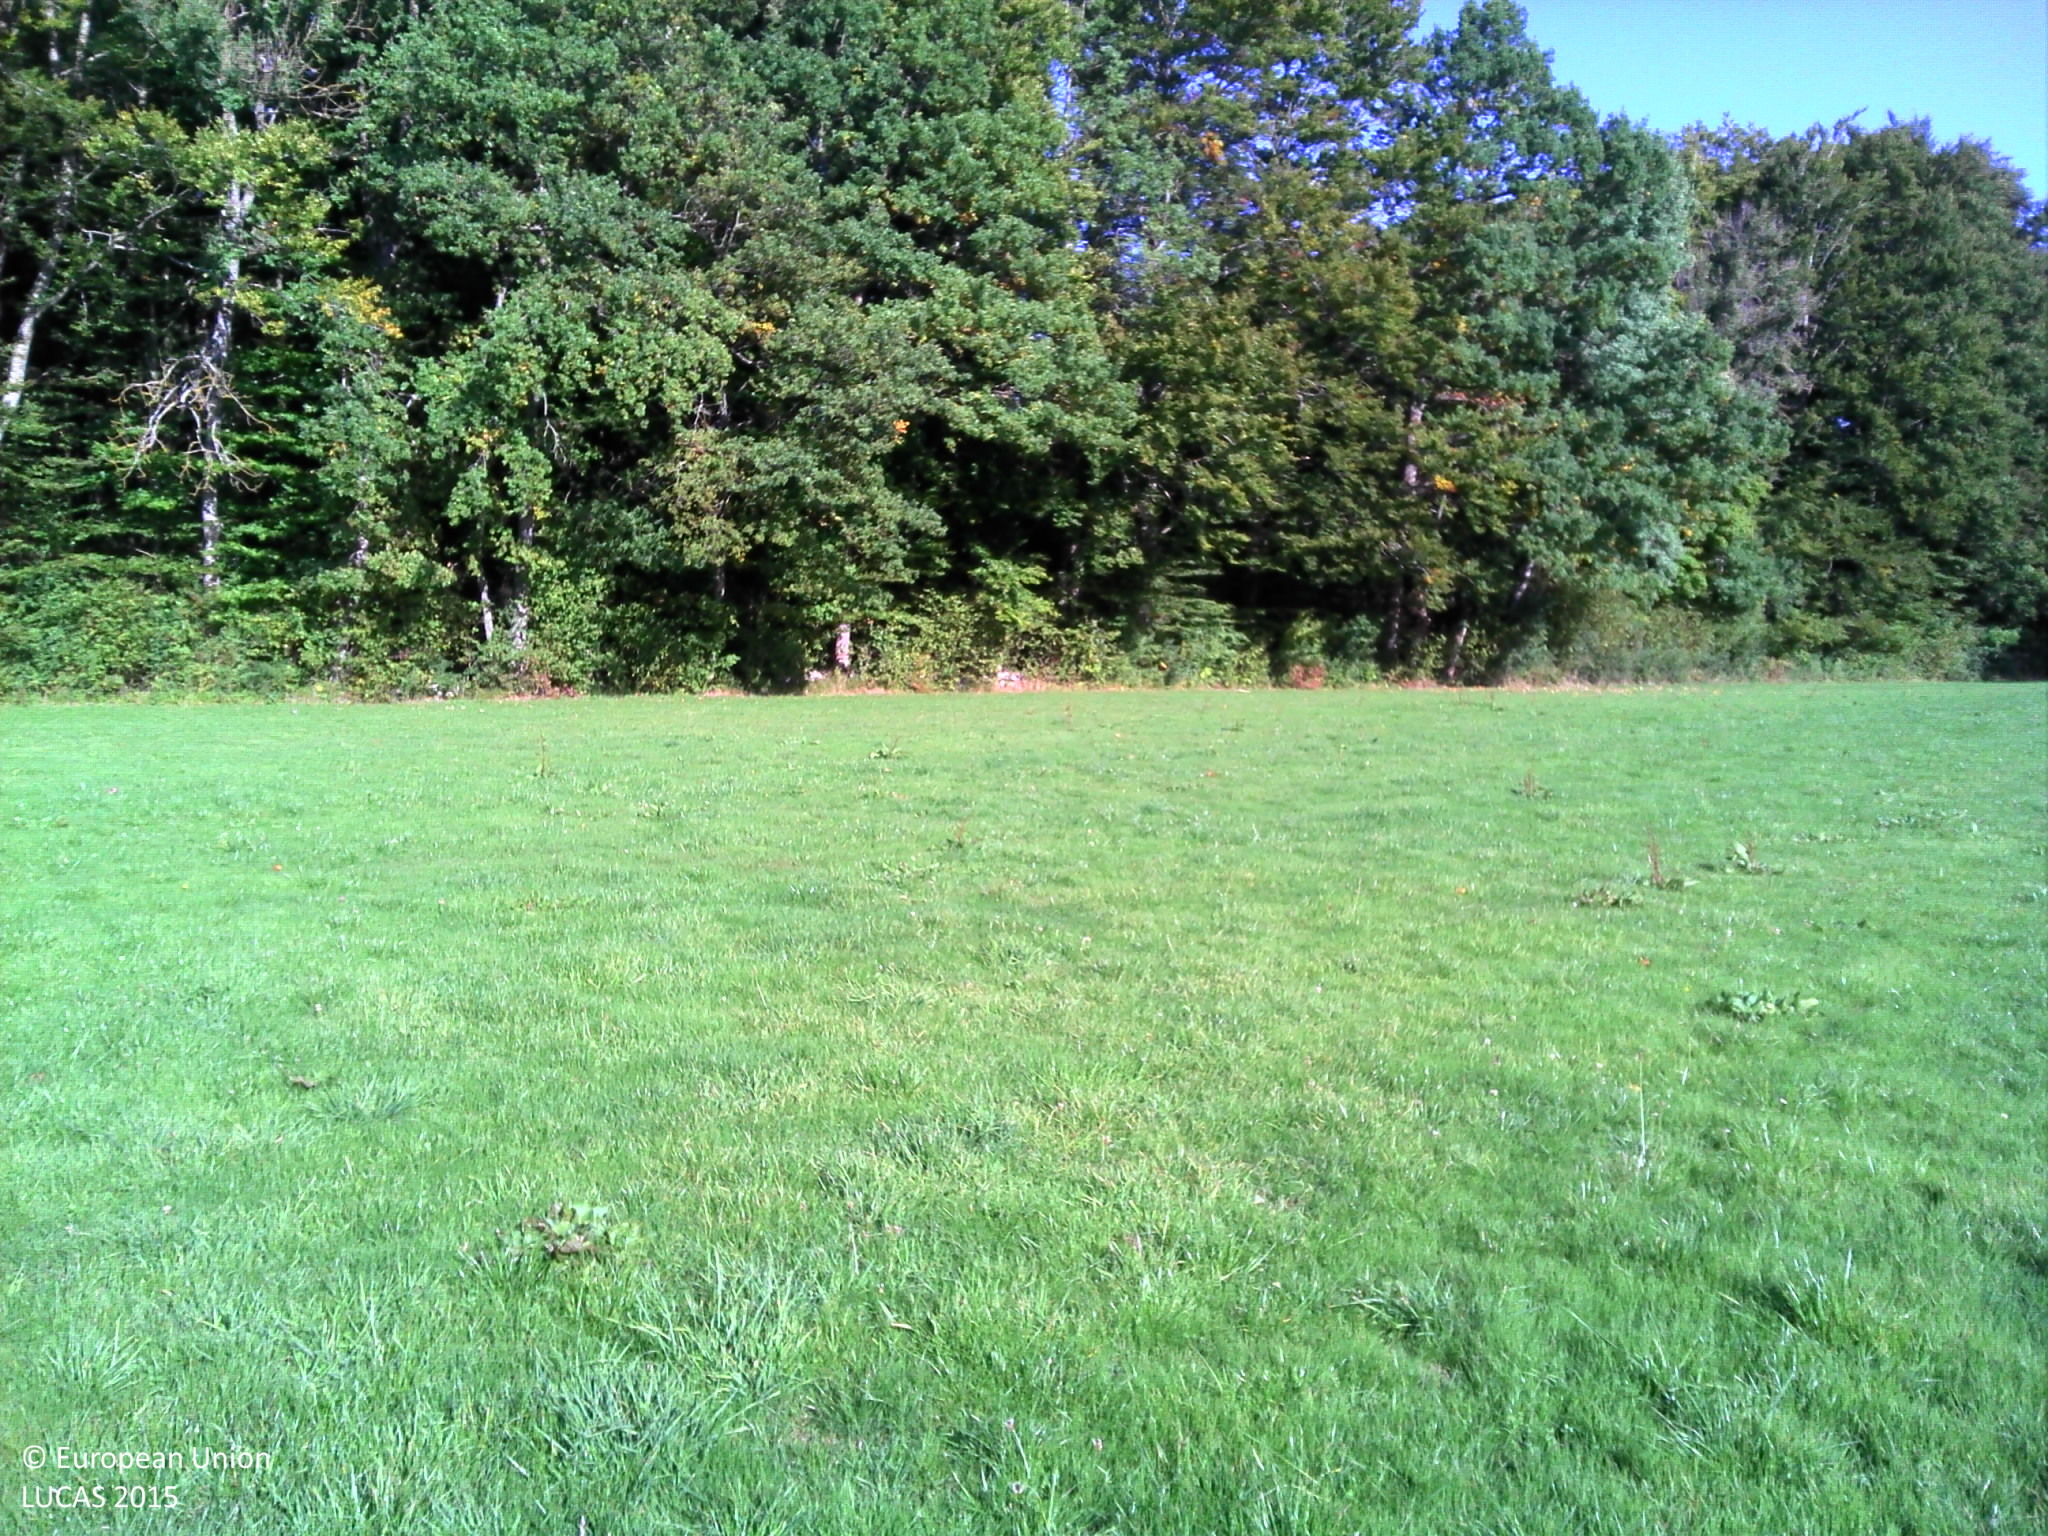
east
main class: Grassland
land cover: Grassland without tree/shrub cover
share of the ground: > 75 %
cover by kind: herbaceous plants 100 %
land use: Agriculture (excluding fallow land and kitchen gardens)
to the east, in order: Grassland without tree/shrub cover; Fences; Dry stone walls; Broadleaved woodland; Spruce dominated coniferous woodland; Fences; Broadleaved woodland
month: September
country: FR
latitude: 47.2598
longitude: 6.8436
